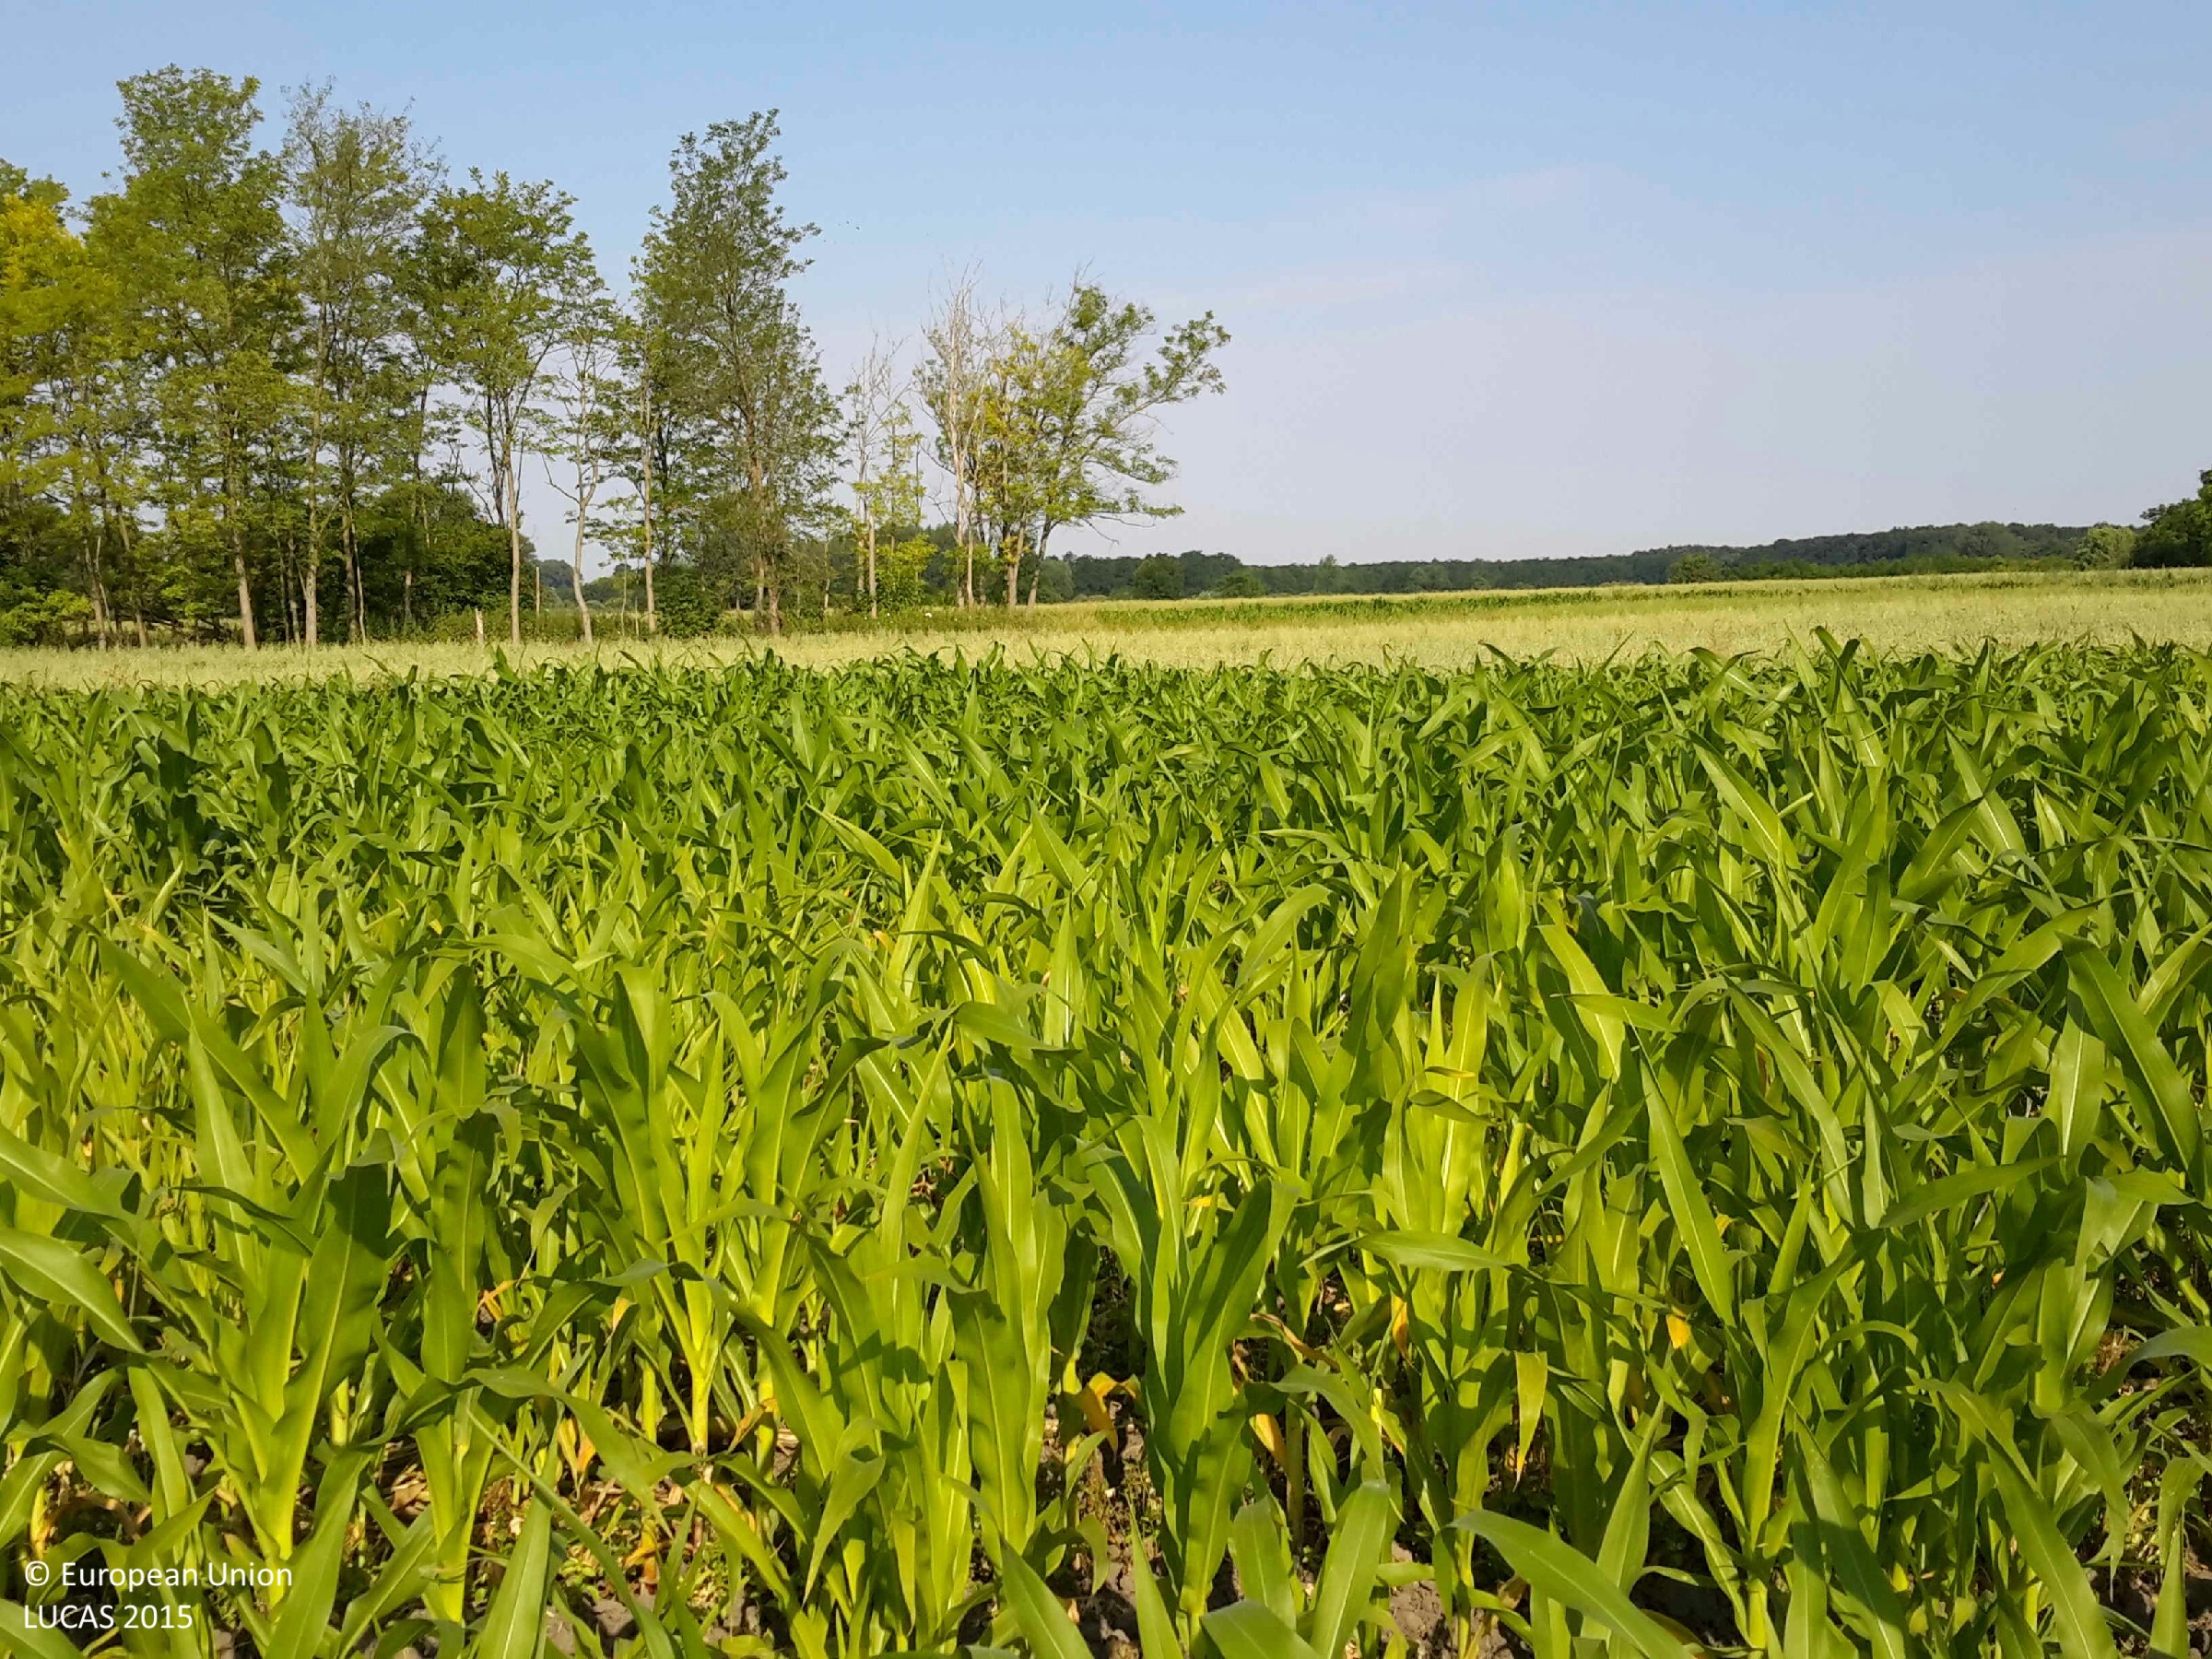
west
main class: Cropland
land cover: Maize
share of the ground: 50 - 75 %
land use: Agriculture (excluding fallow land and kitchen gardens)
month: July
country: HU
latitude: 47.4419
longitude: 17.5268
